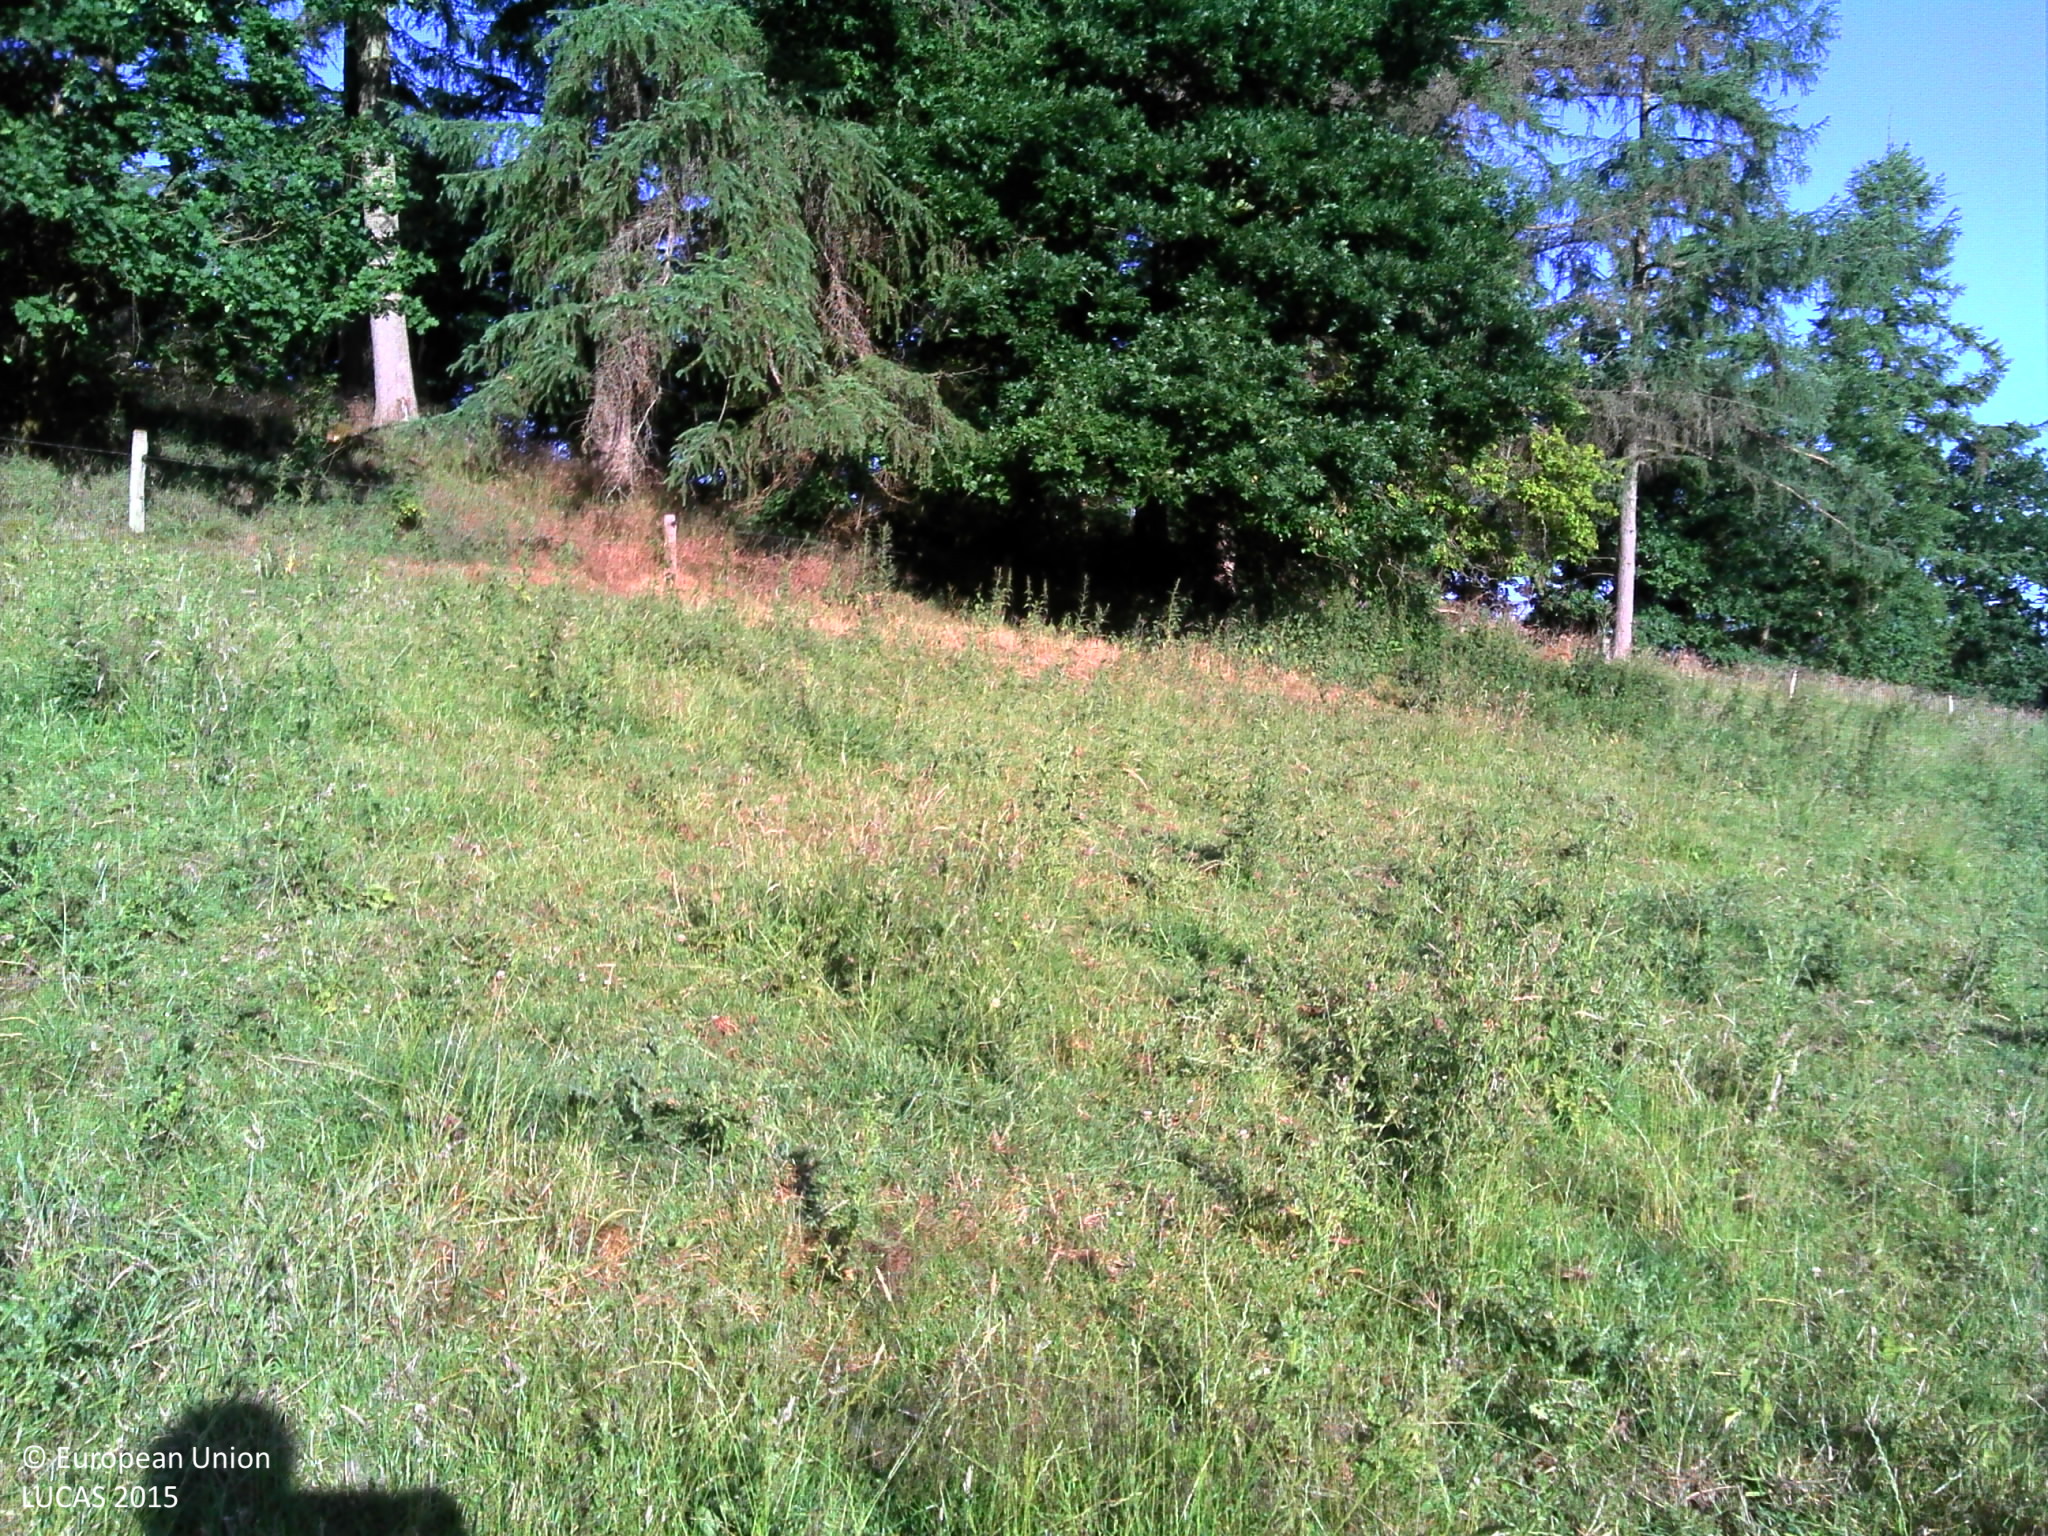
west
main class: Grassland
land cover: Grassland without tree/shrub cover
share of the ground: > 75 %
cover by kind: herbaceous plants 100 %
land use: Agriculture (excluding fallow land and kitchen gardens)
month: July
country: BE
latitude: 50.1182
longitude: 5.6210
